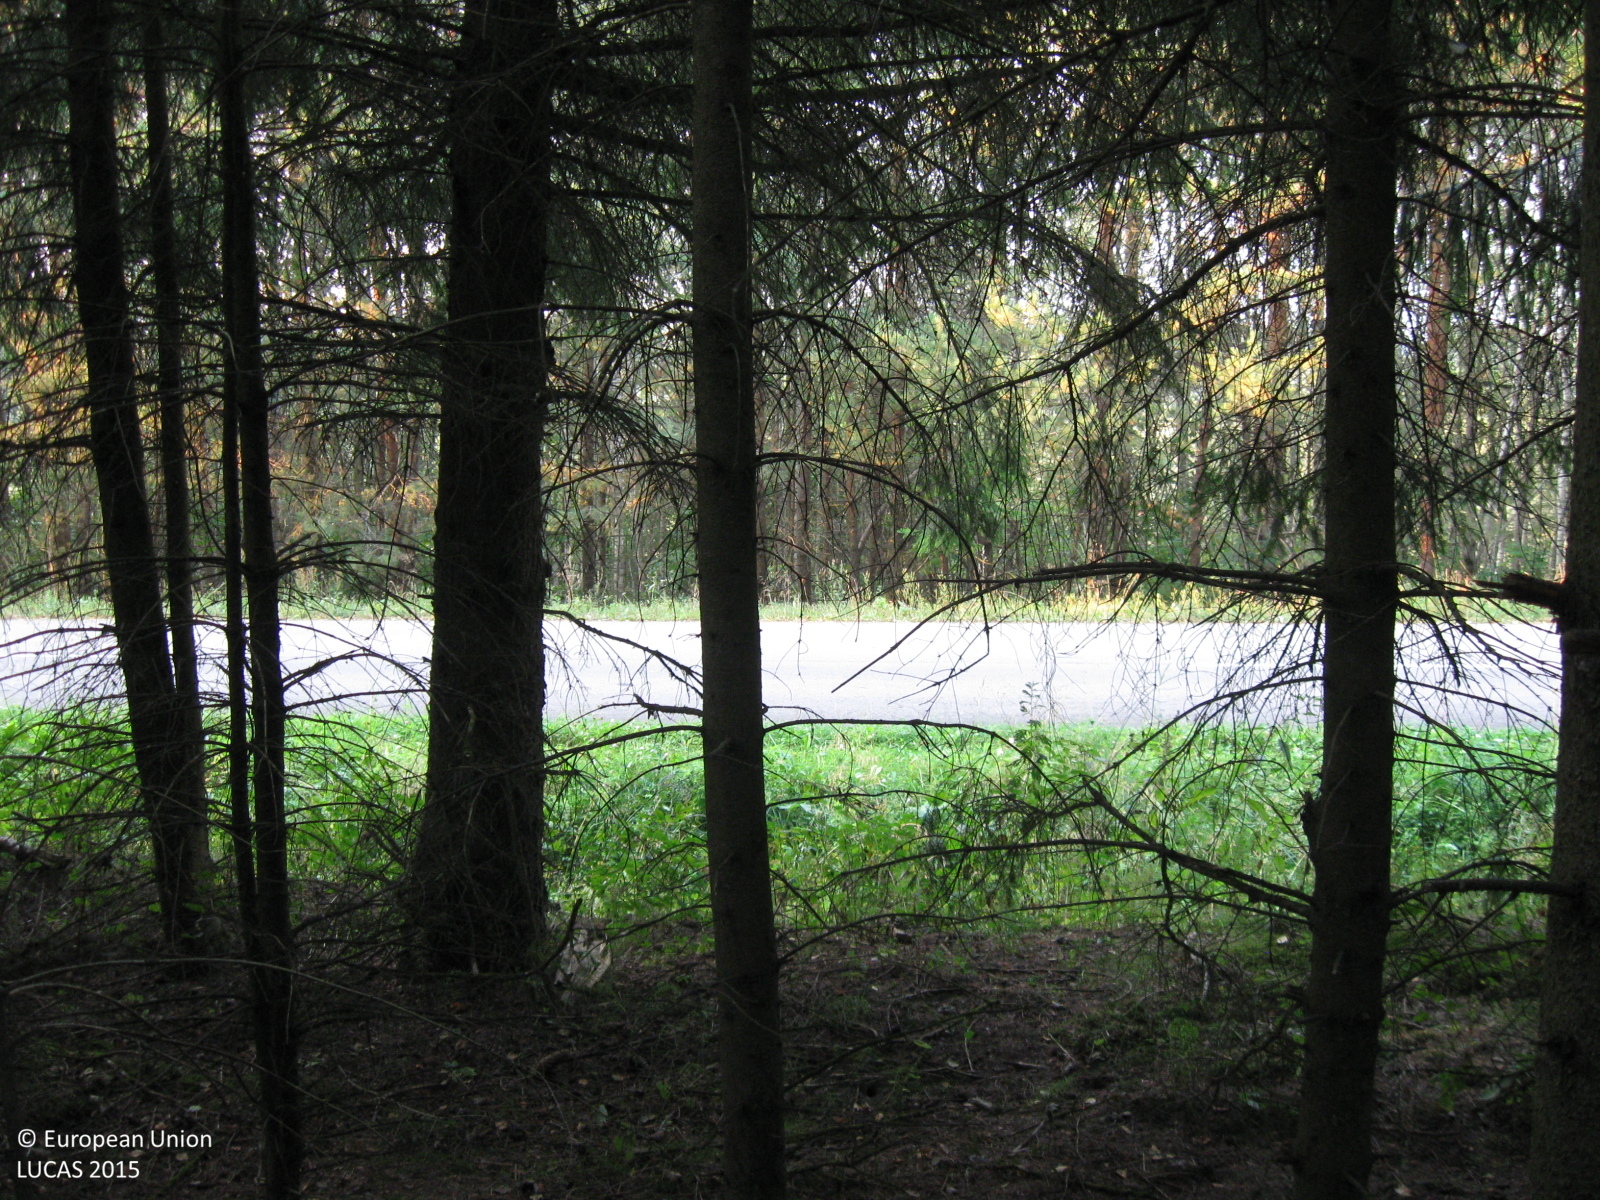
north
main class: Woodland
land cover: Spruce dominated mixed woodland
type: hemiboreal forest and nemoral coniferous forest and mixed broadleaved-coniferous forest
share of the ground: > 75 %
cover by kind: coniferous forest trees 55 %, broadleaved forest trees 35 %, herbaceous plants 10 %
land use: Forestry
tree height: > 5 m
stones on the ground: < 10 %
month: September
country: LT
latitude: 55.0837
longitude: 23.1866
